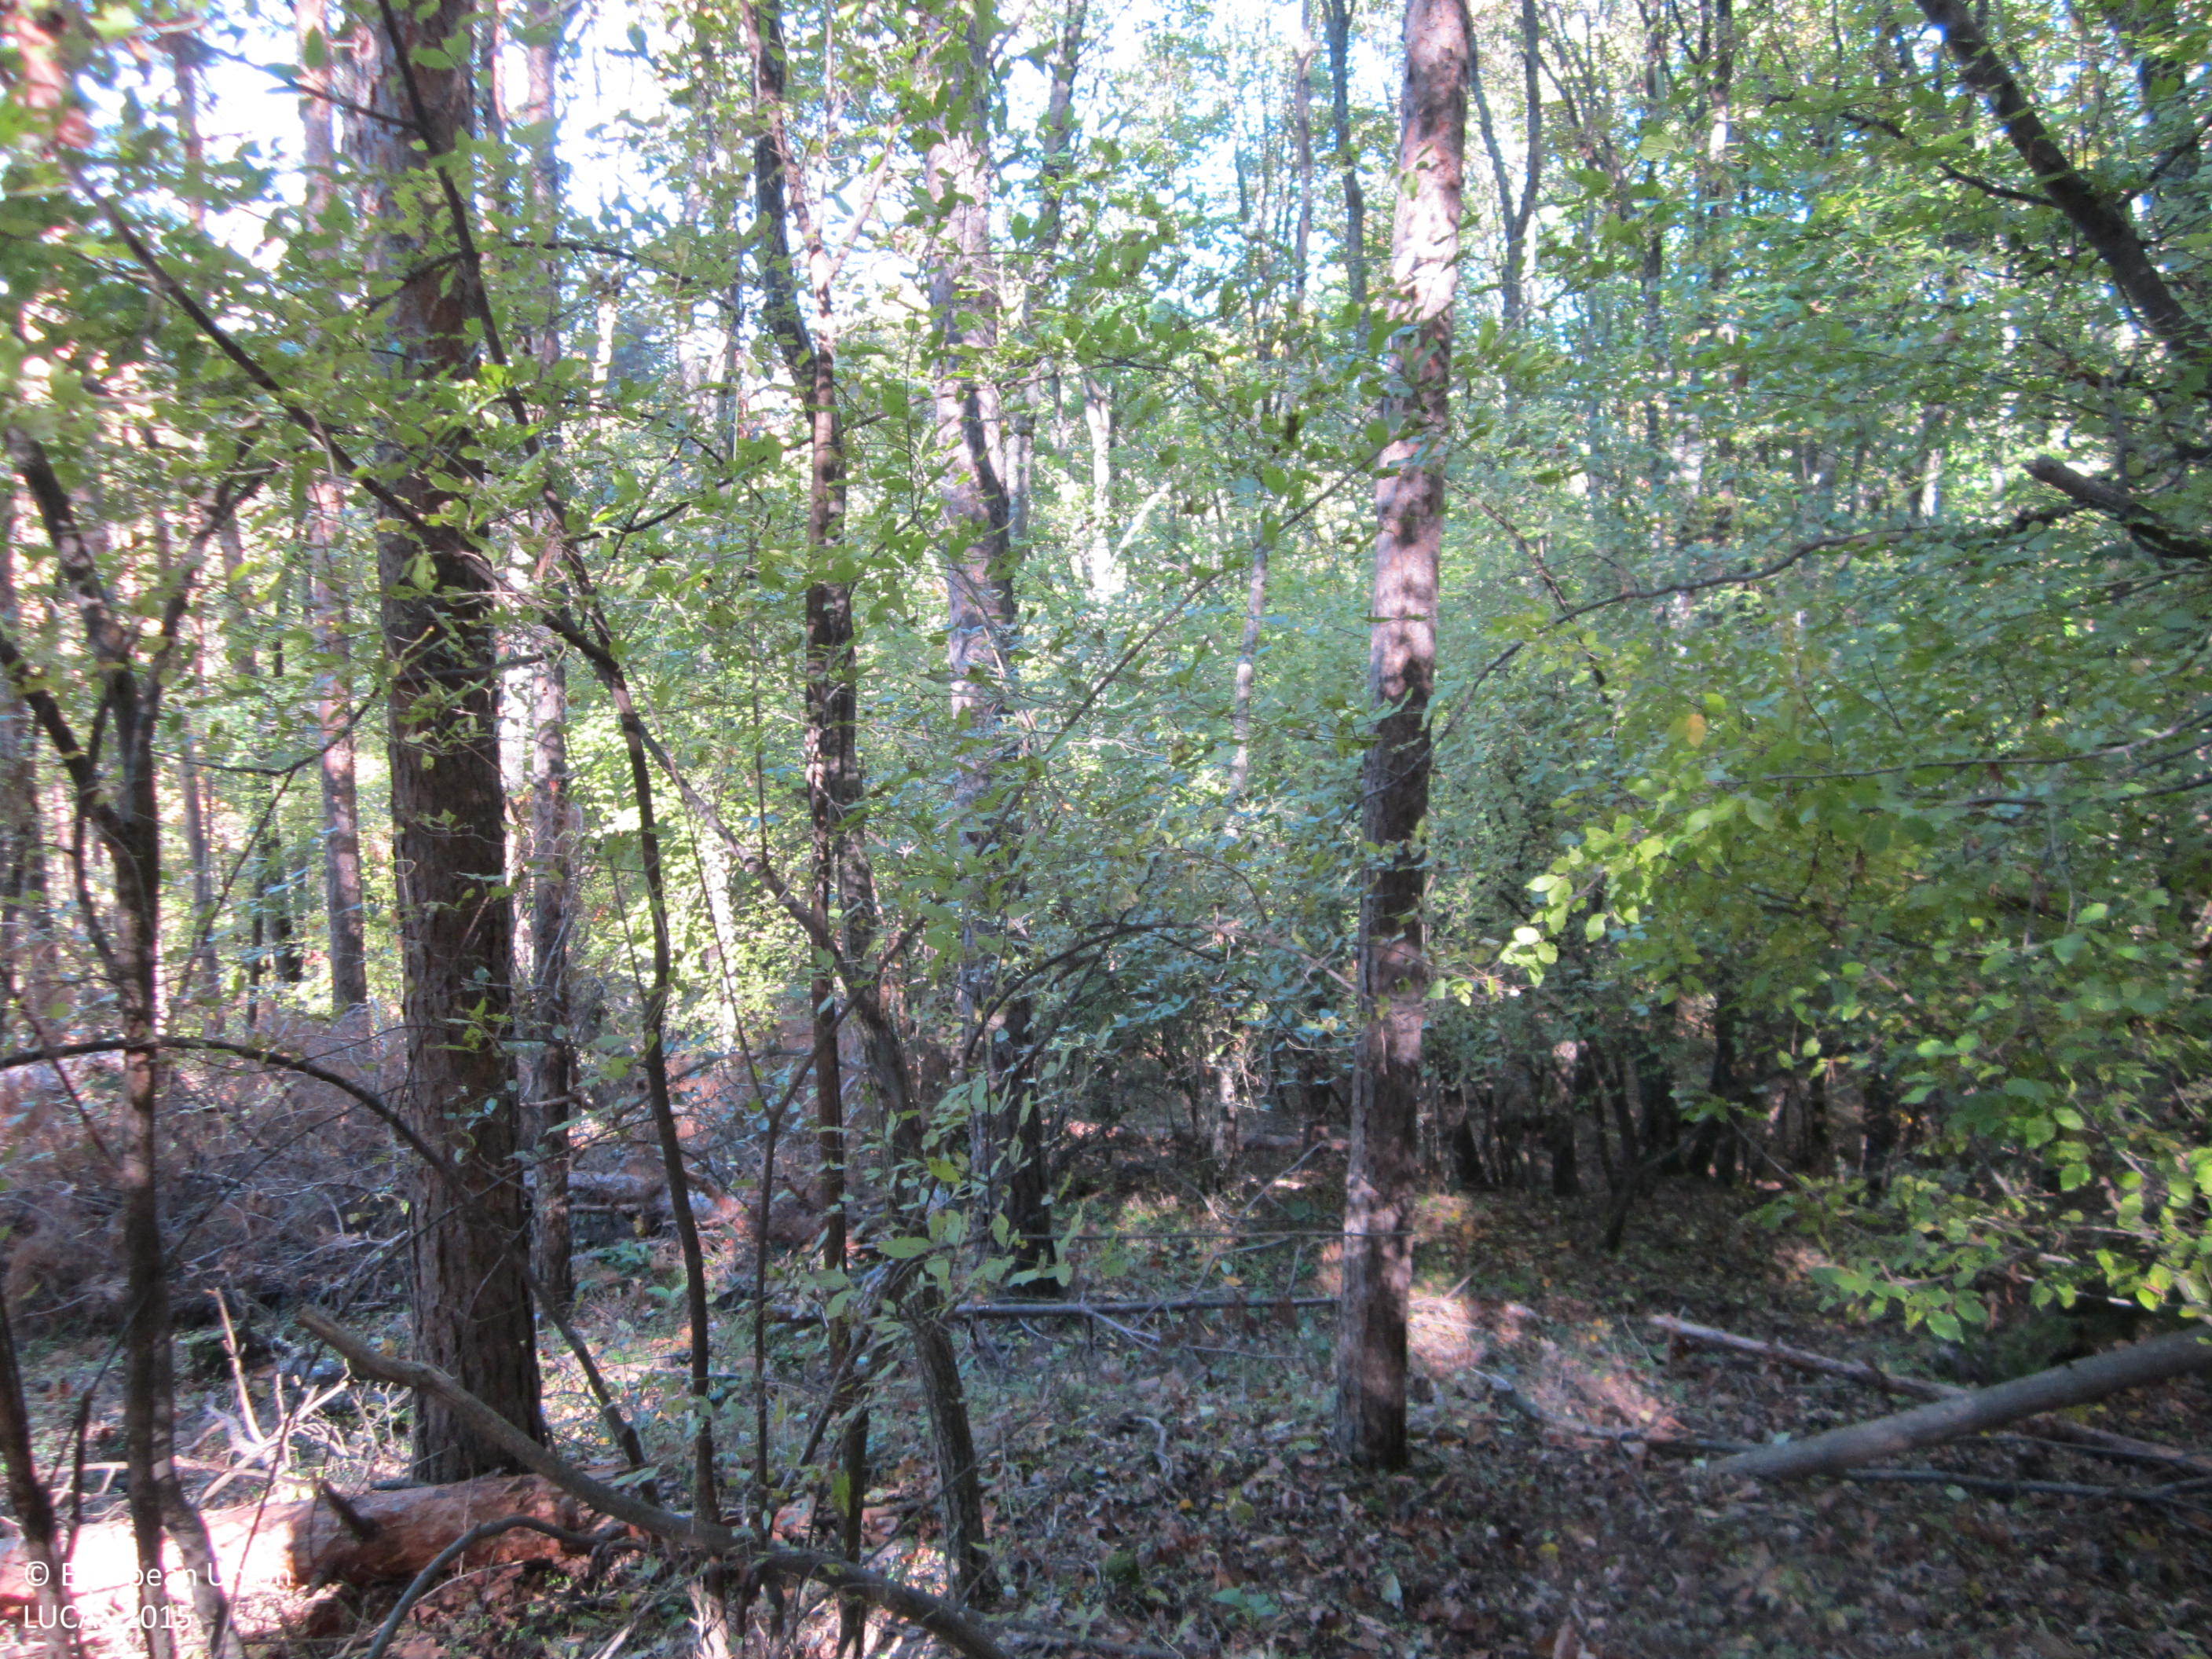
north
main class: Woodland
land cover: Pine dominated mixed woodland
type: hemiboreal forest and nemoral coniferous forest and mixed broadleaved-coniferous forest
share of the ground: > 75 %
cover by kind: coniferous forest trees 60 %, broadleaved forest trees 20 %, herbaceous plants 10 %, unconsolidated bare surface 10 %
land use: Forestry
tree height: > 5 m
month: November
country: BG
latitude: 41.4060
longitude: 25.7924
